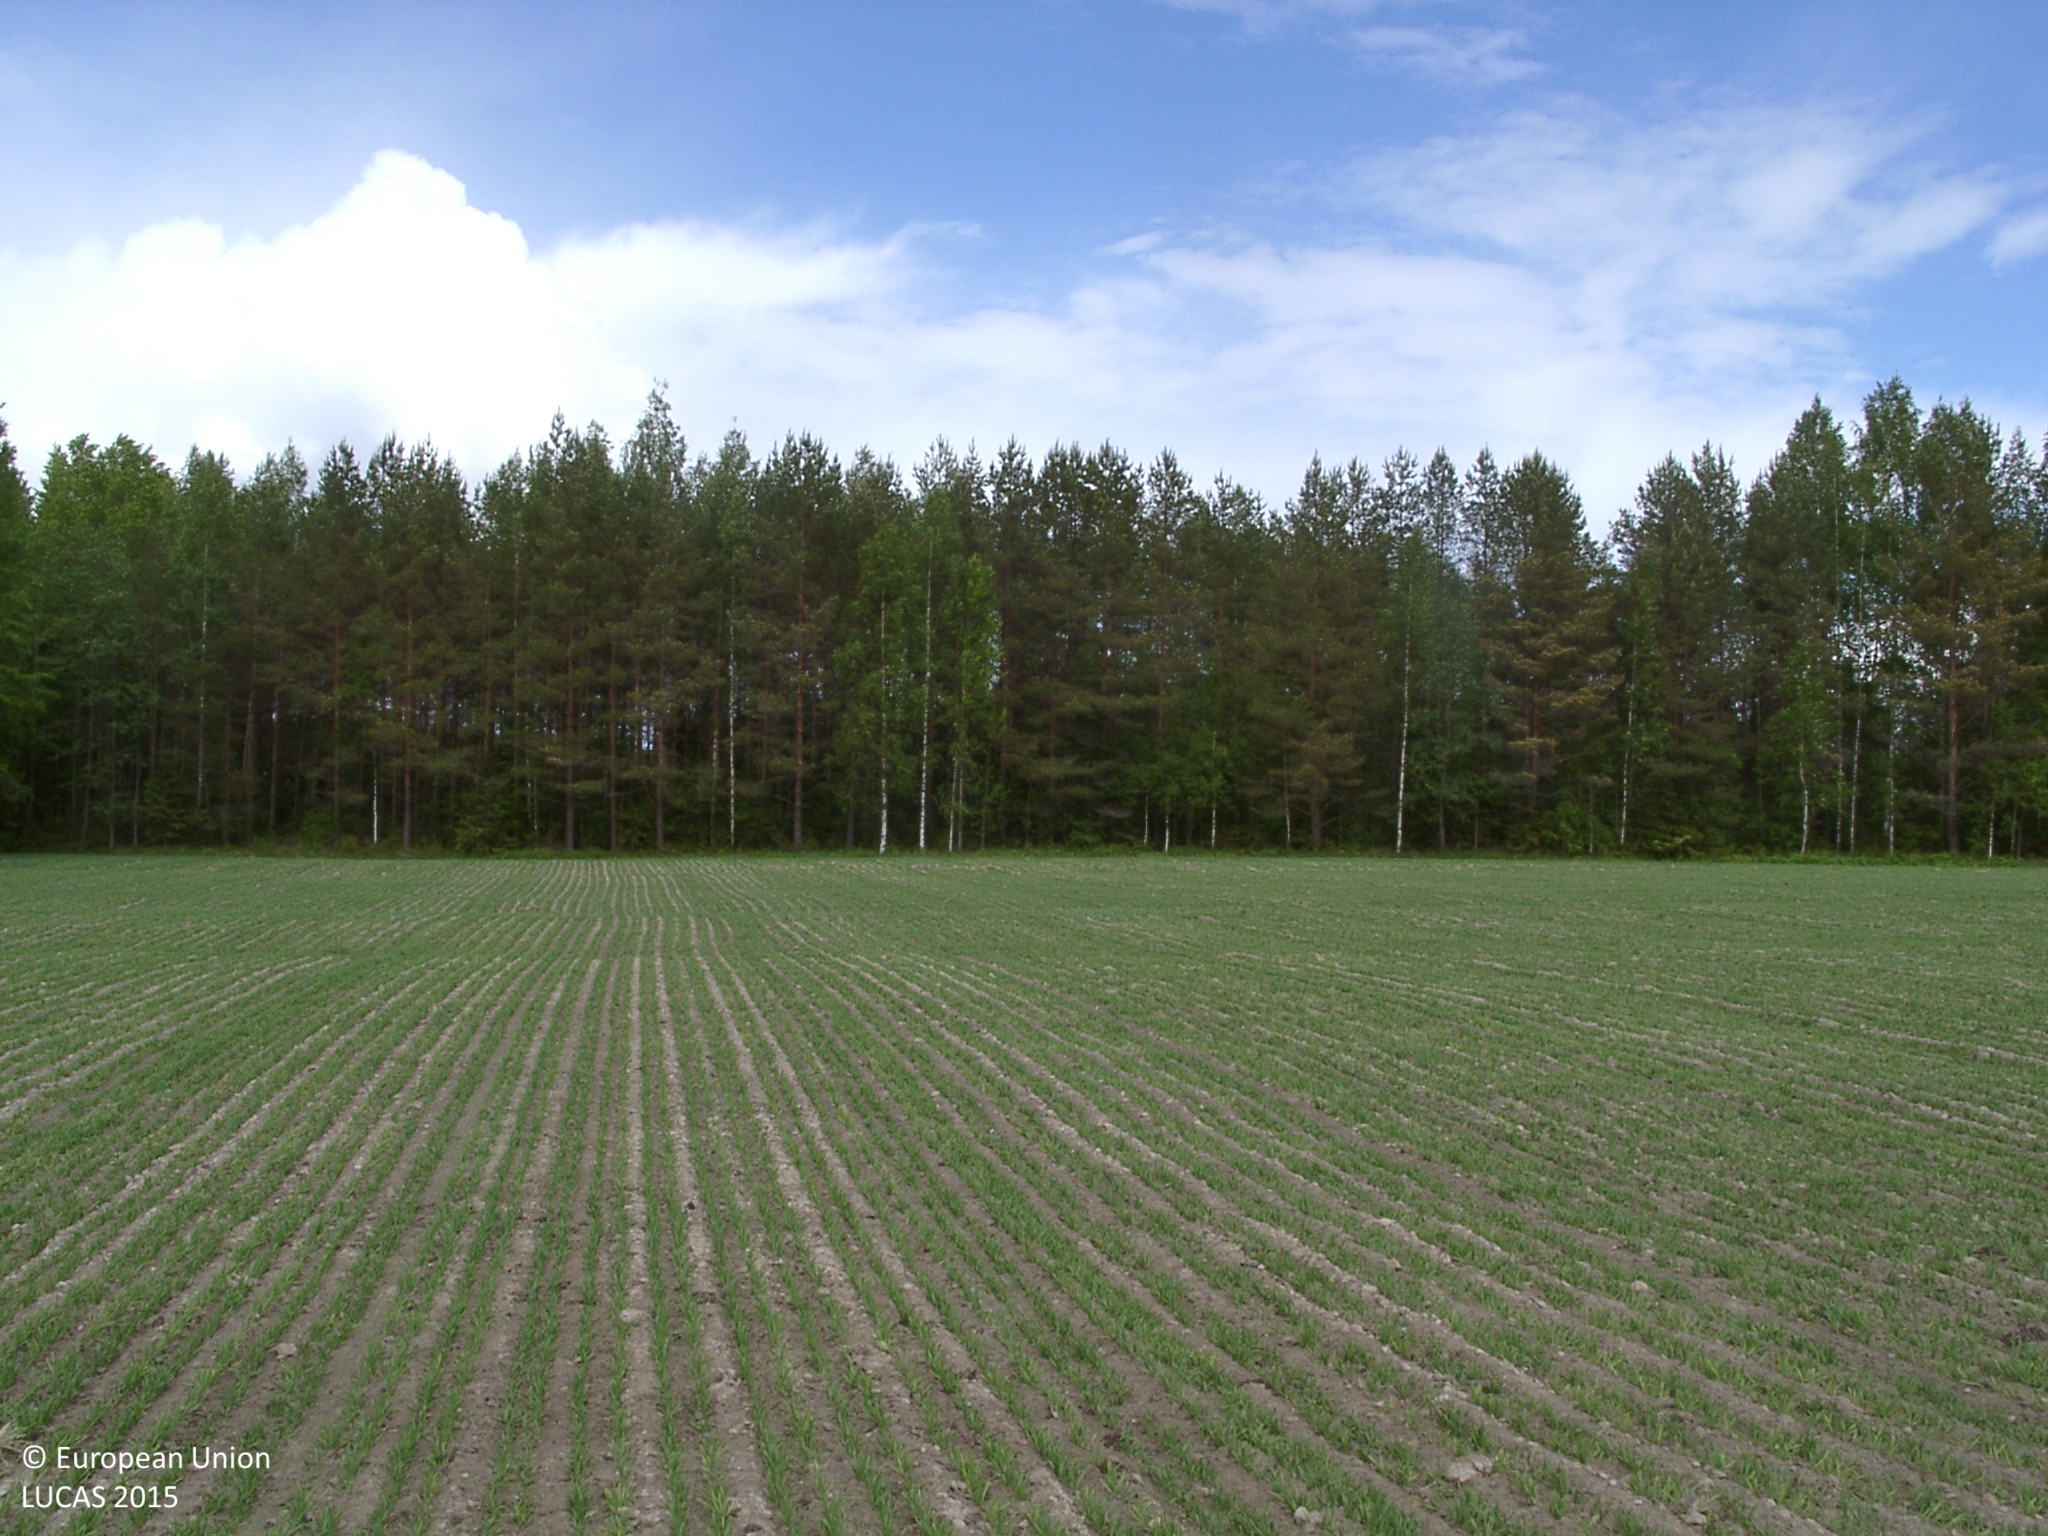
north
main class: Cropland
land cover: Oats
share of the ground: 25 - 50 %
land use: Agriculture (excluding fallow land and kitchen gardens)
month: June
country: FI
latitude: 61.8659
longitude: 24.5248
